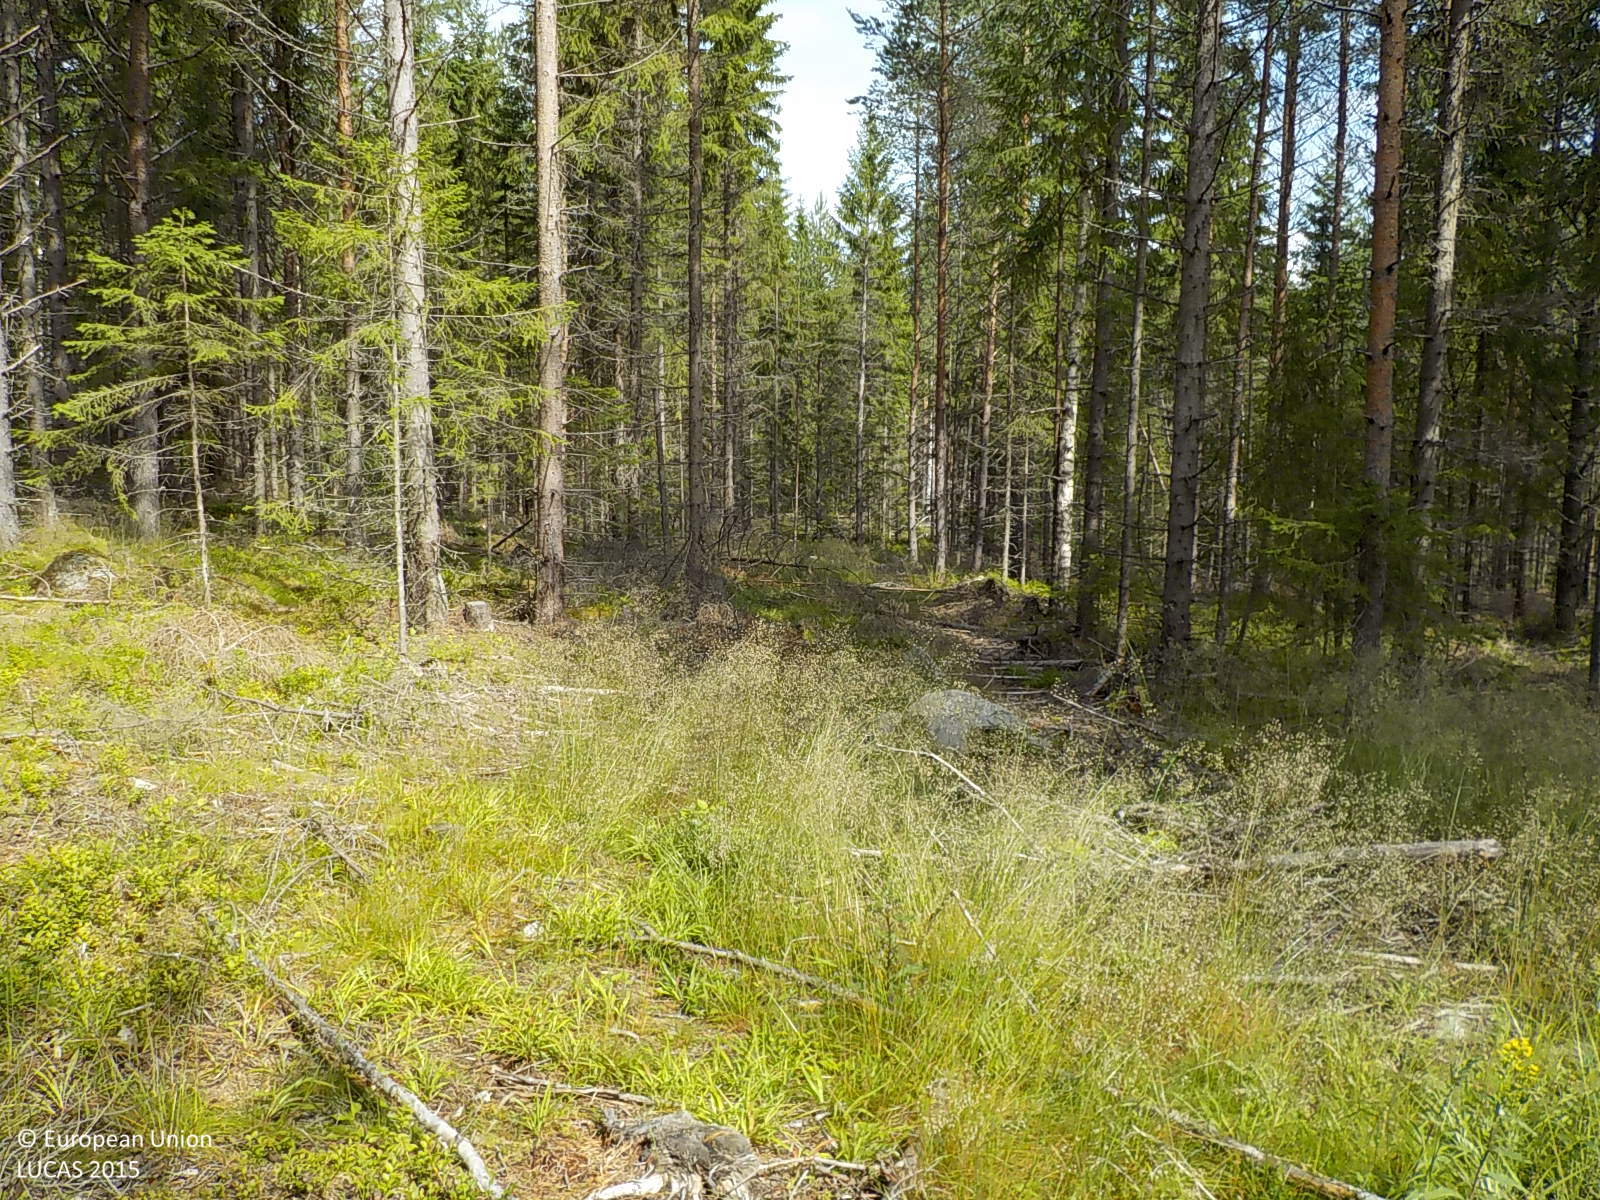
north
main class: Woodland
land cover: Pine dominated coniferous woodland
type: boreal forest
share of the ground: 50 - 75 %
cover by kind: coniferous forest trees 70 %, herbaceous plants 10 %, broadleaved forest trees 5 %, shrubs 5 %
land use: Forestry
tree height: > 5 m
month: July
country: SE
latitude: 63.1940
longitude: 17.3496
